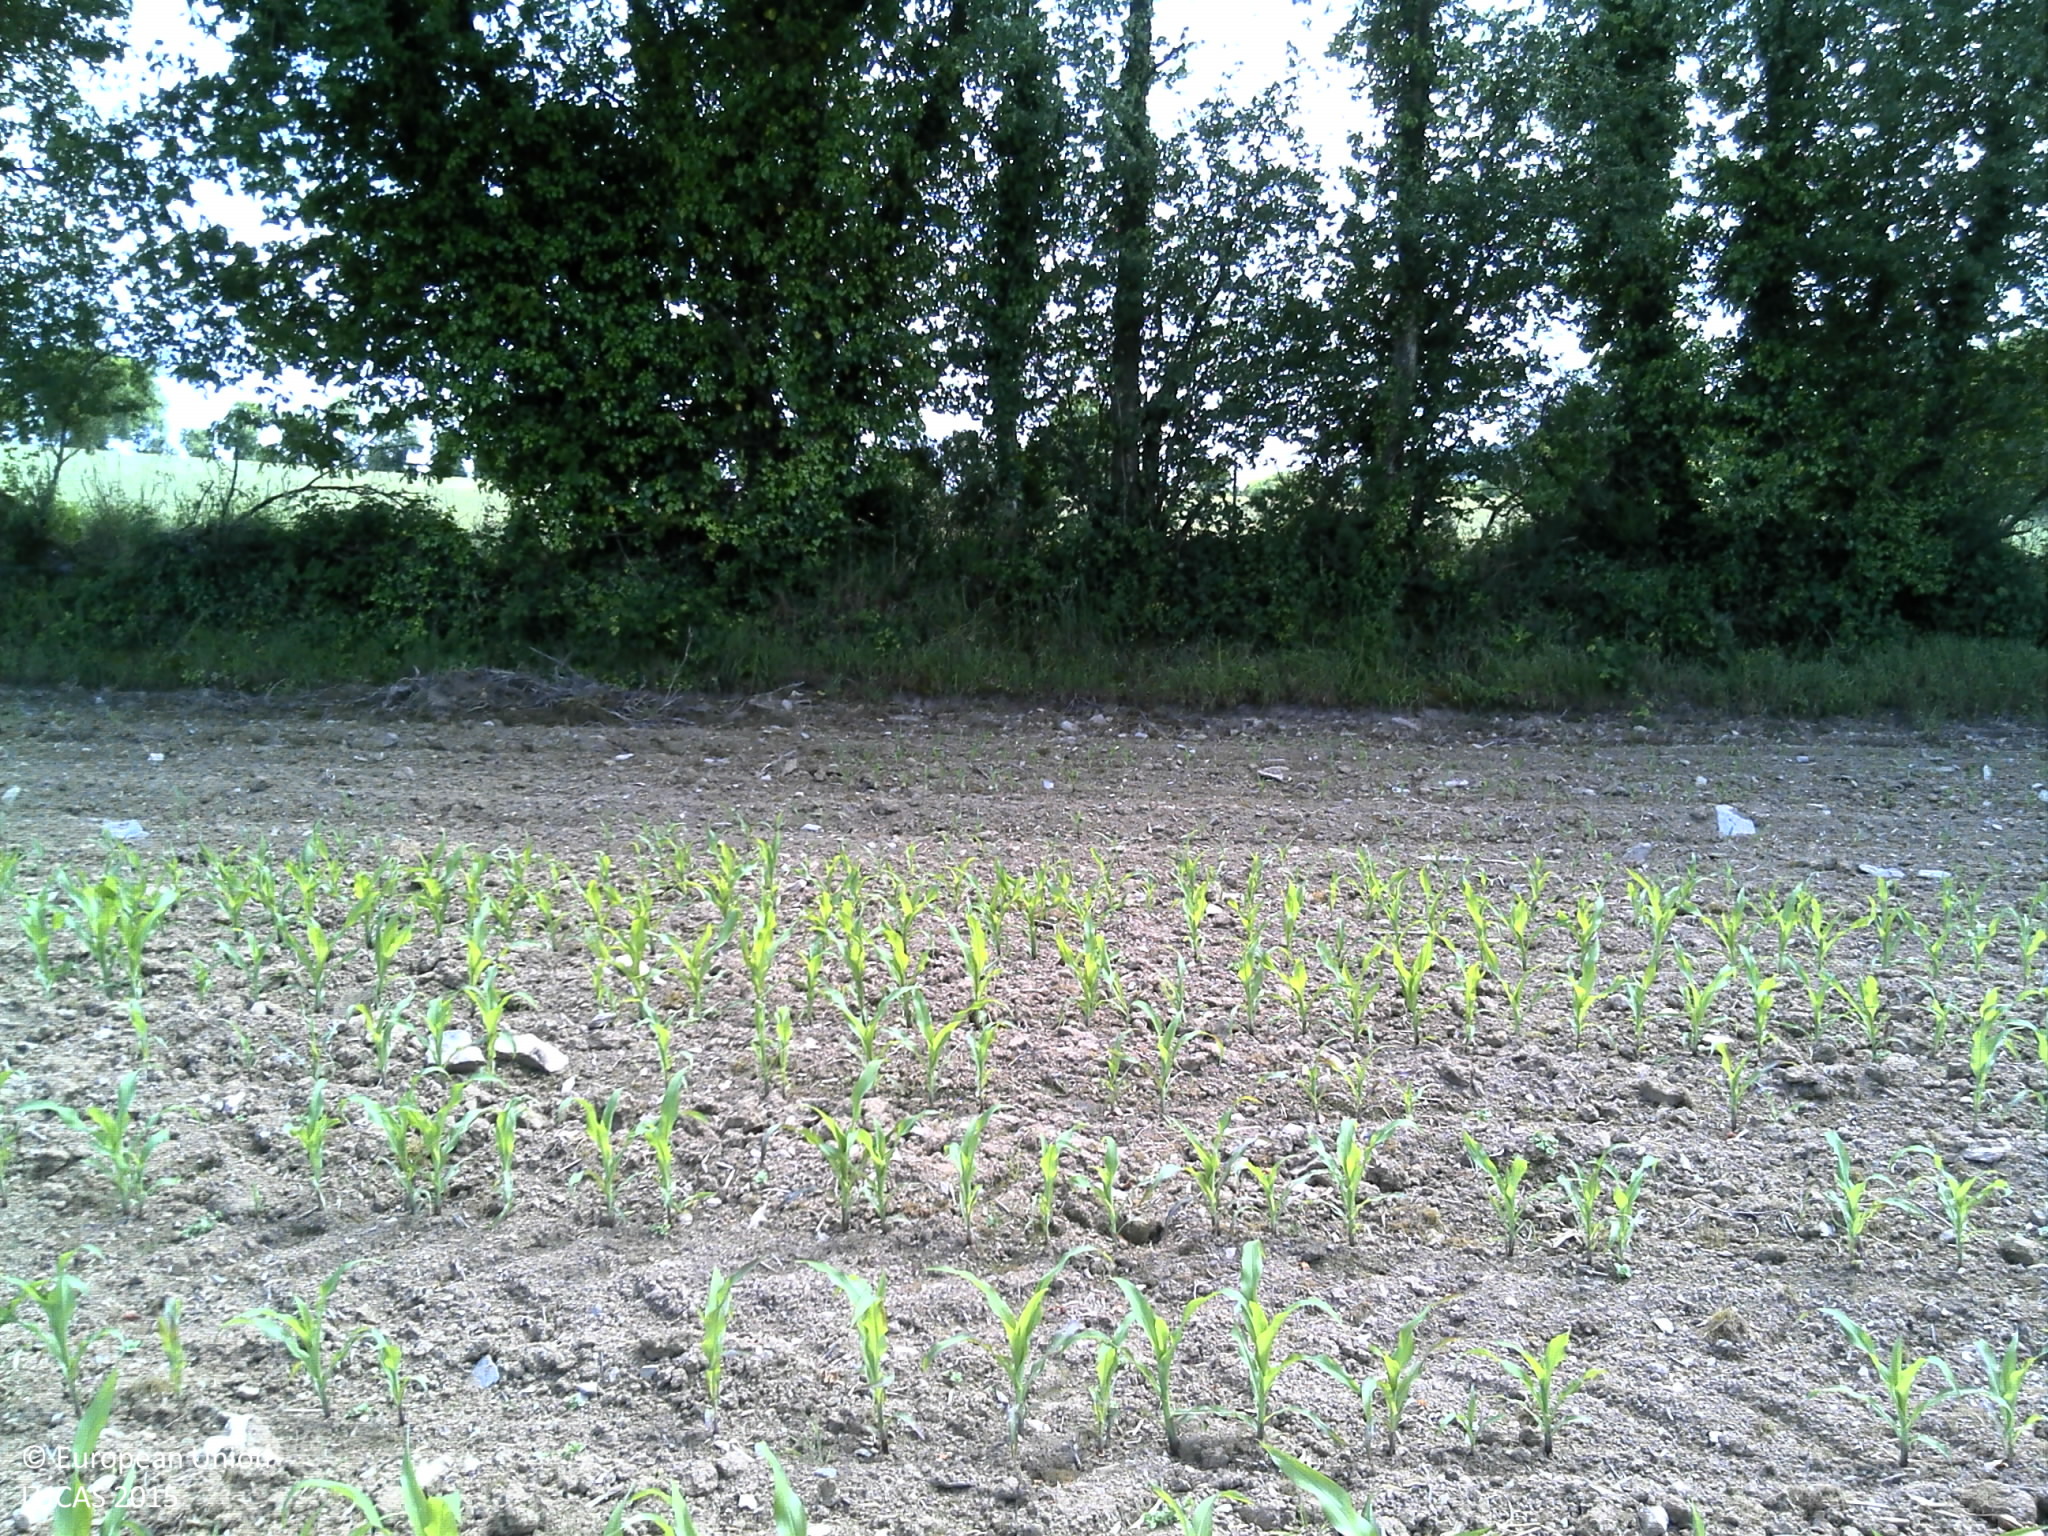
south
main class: Cropland
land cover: Maize
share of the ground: 10 - 25 %
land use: Agriculture (excluding fallow land and kitchen gardens)
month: June
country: FR
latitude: 48.4372
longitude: -3.7216
